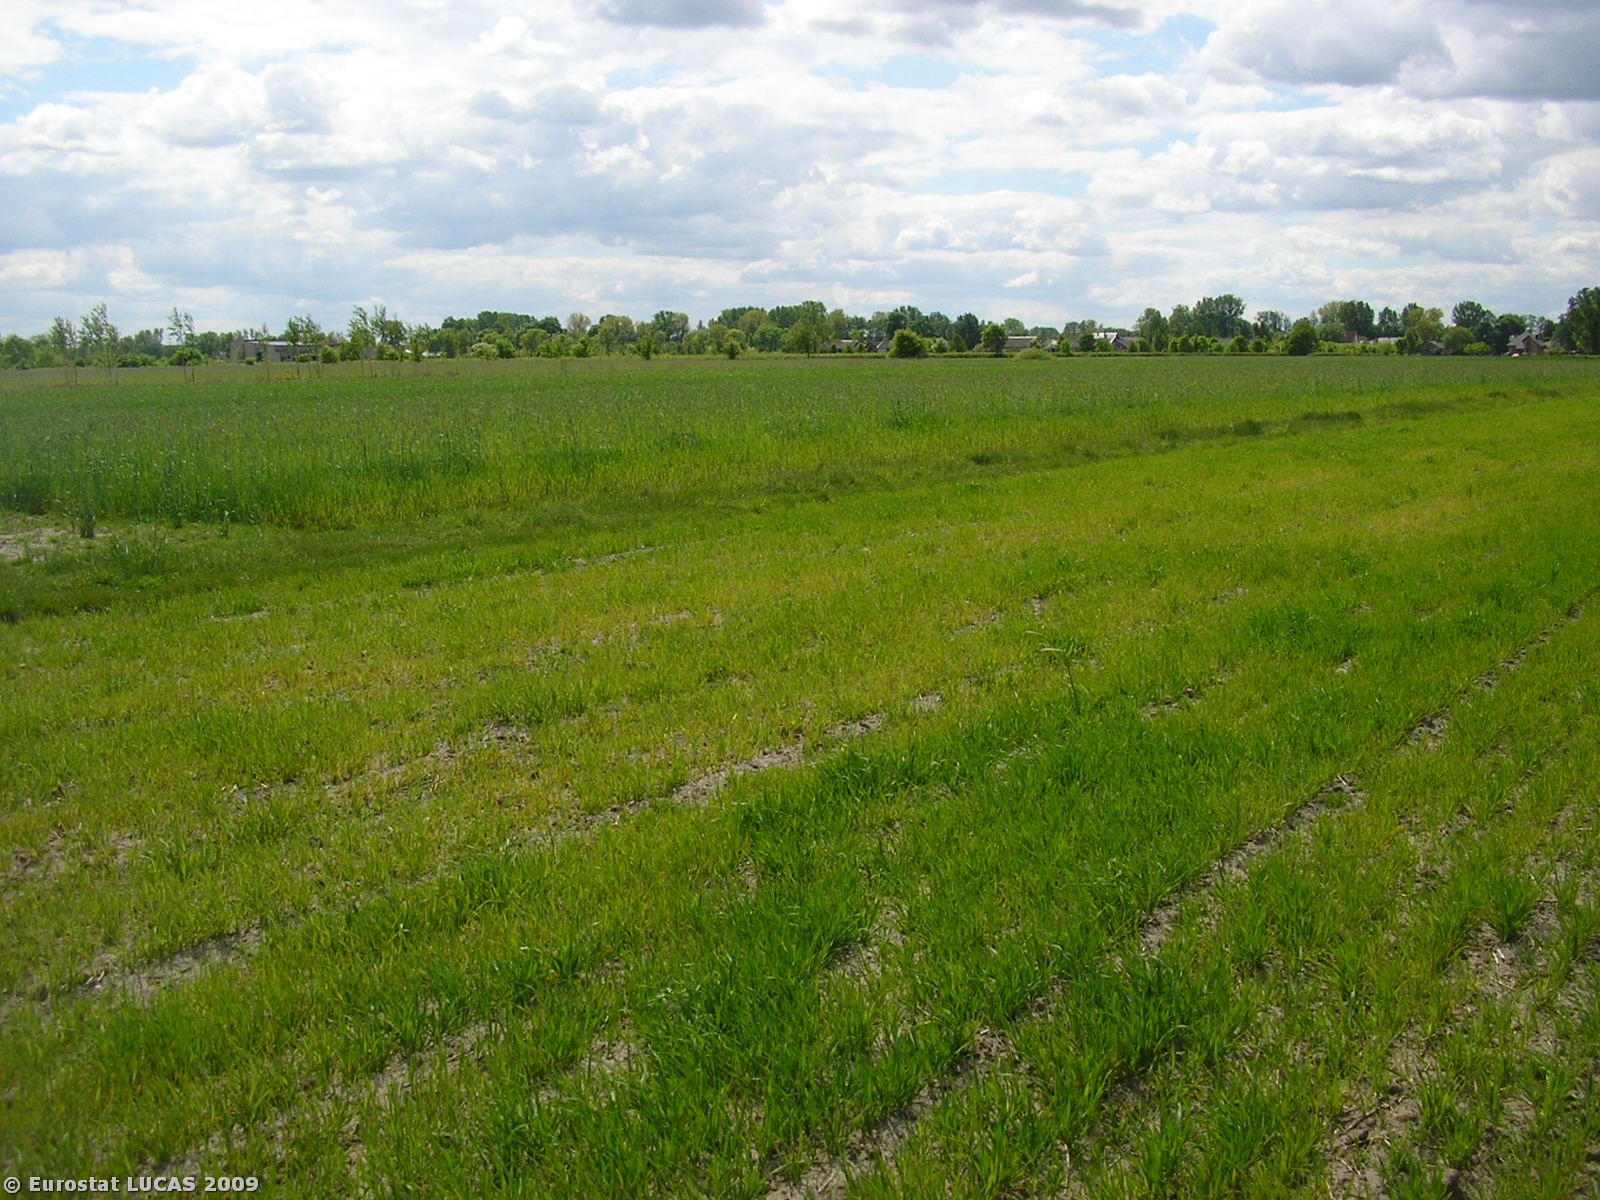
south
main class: Cropland
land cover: Oats
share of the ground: 10 - 25 %
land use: Agriculture (excluding fallow land and kitchen gardens)
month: May
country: PL
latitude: 51.9848
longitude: 20.0659
